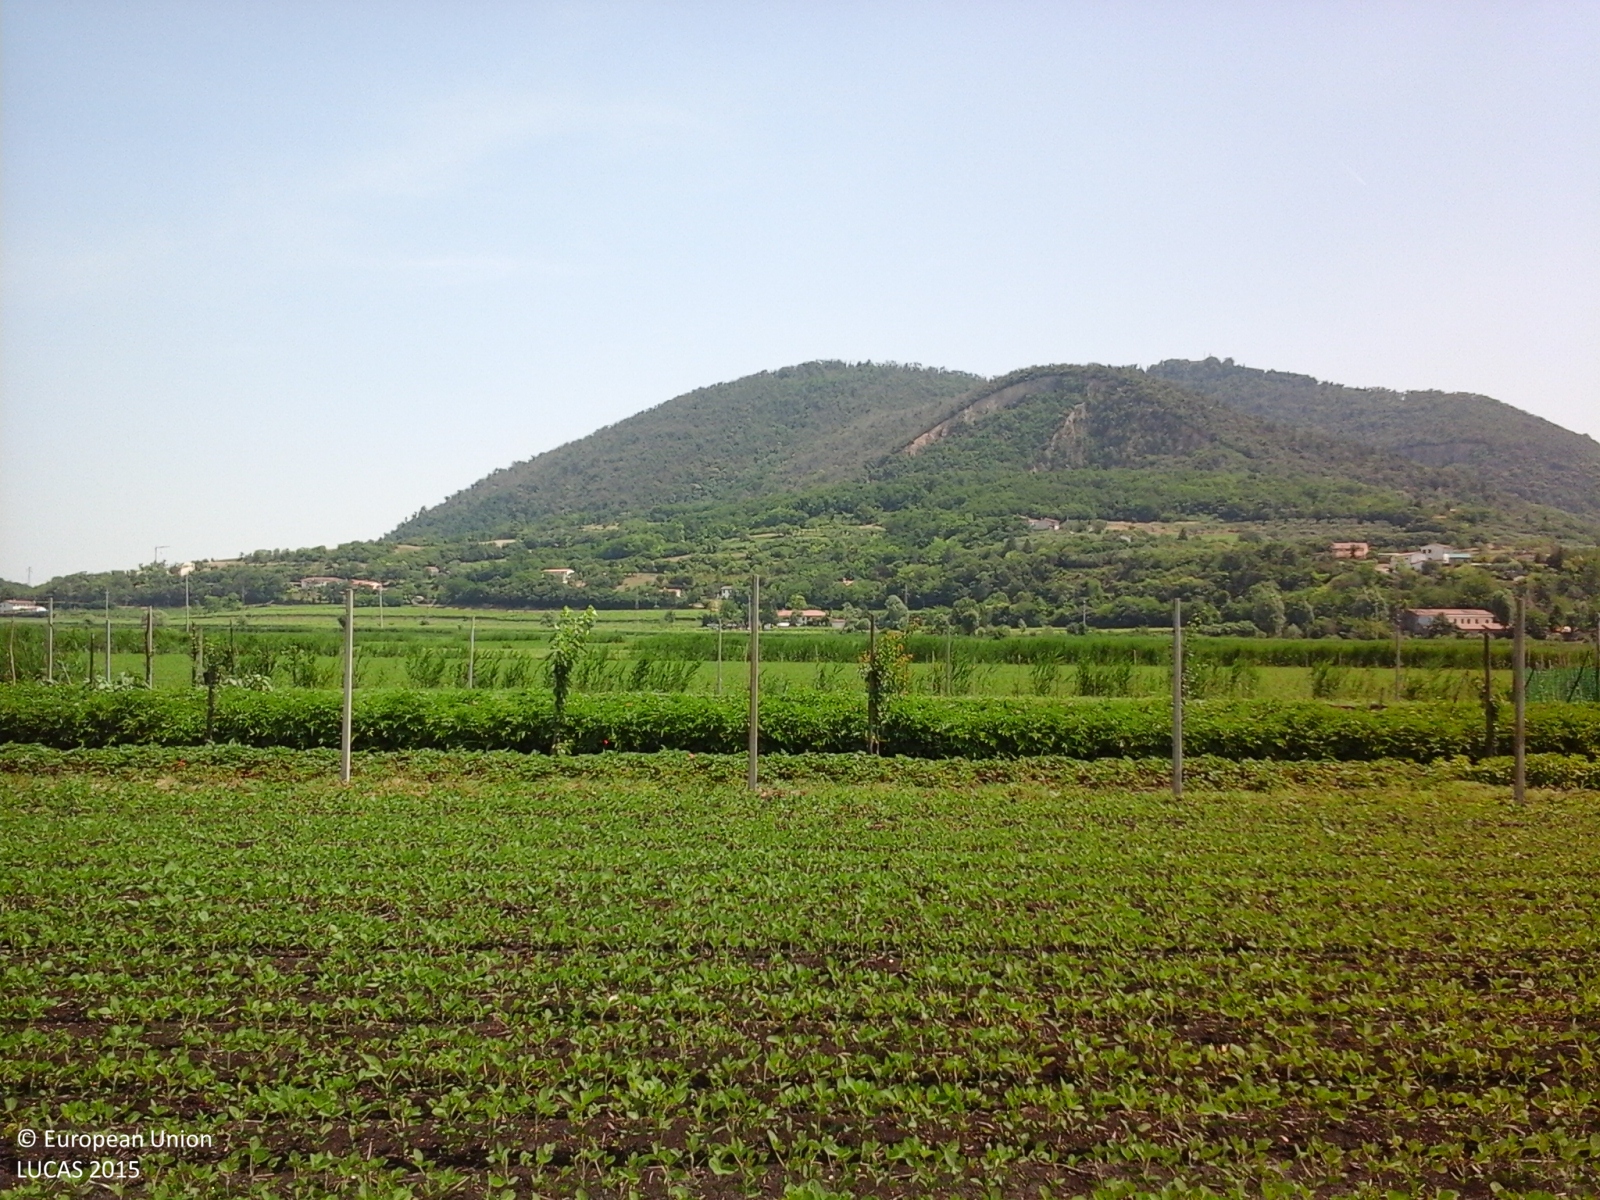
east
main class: Cropland
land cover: Soya
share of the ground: 25 - 50 %
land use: Agriculture (excluding fallow land and kitchen gardens)
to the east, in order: Soya; Other fresh vegetables; Ditches and canals; Soya; Ditches and canals; Soya; Ditches and canals; Soya; Maize; Ditches and canals; Soya
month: June
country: IT
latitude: 45.2561
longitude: 11.7173
